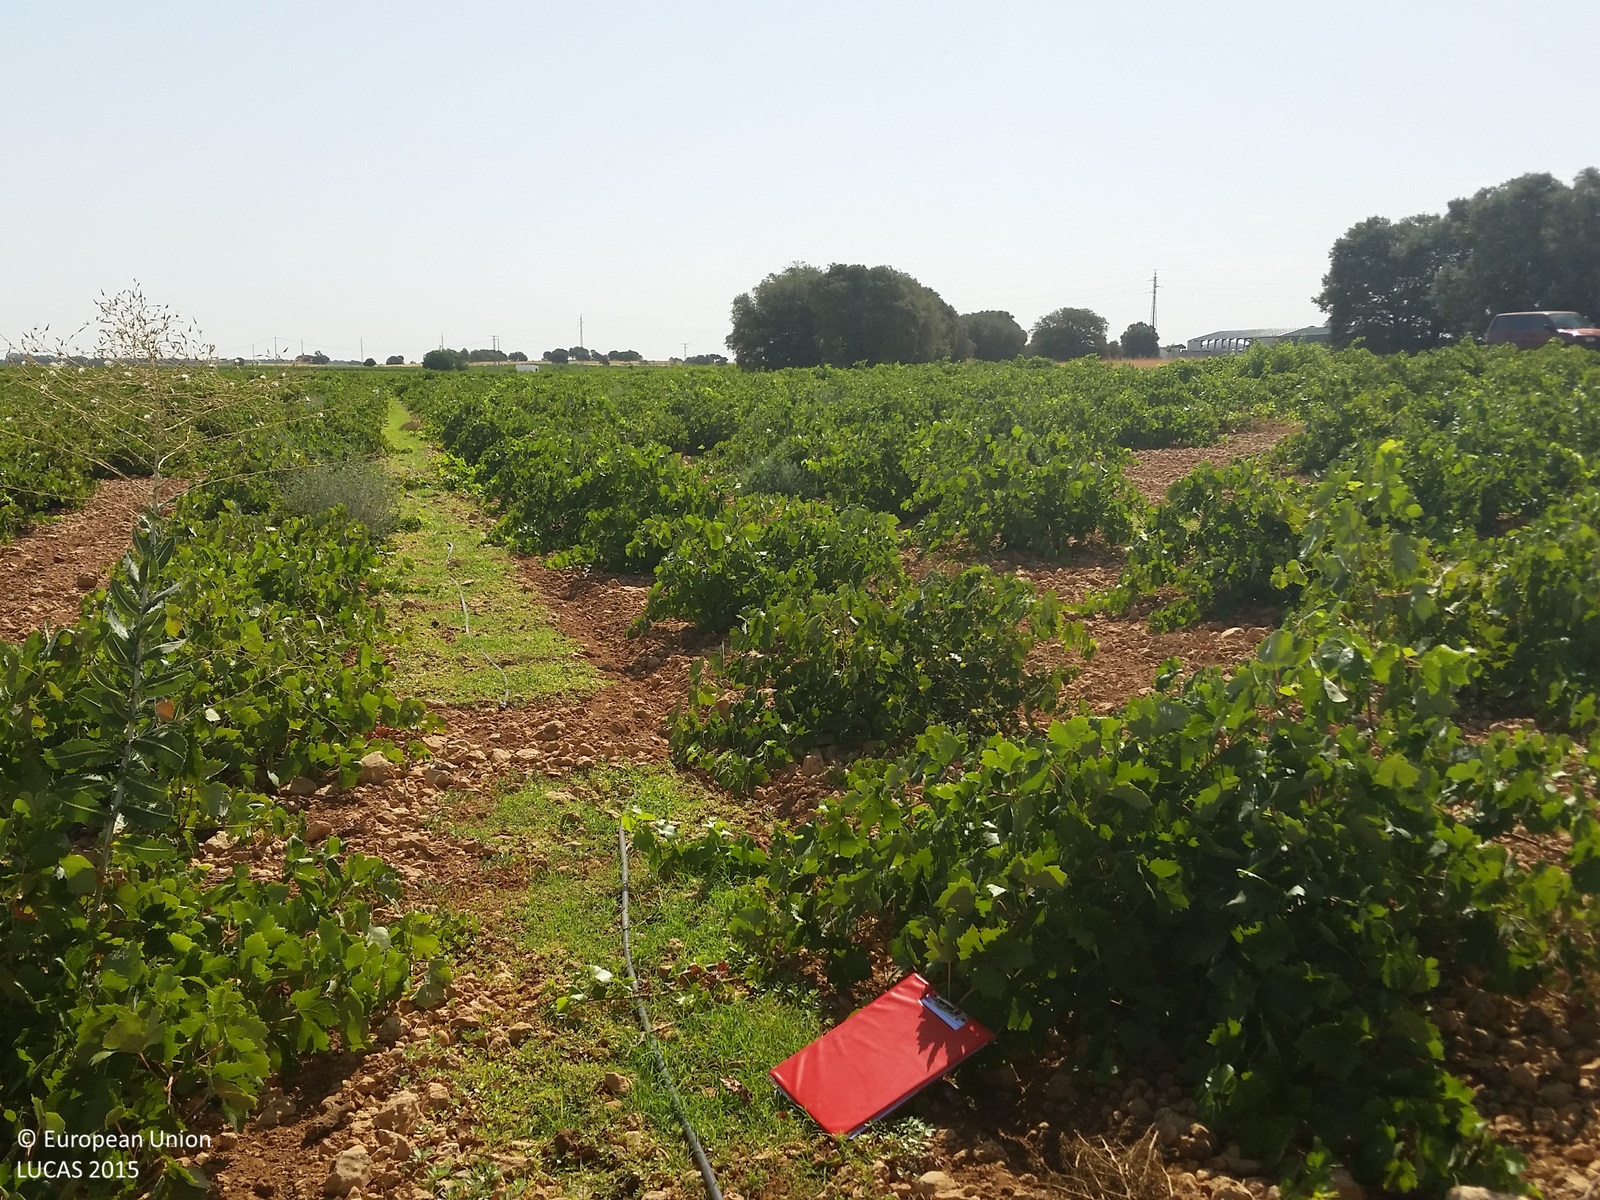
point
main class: Cropland
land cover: Vineyards
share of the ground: 50 - 75 %
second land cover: Spontaneously vegetated surfaces
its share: 50 - 75 %
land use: Agriculture (excluding fallow land and kitchen gardens)
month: July
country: ES
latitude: 39.3090
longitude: -2.5702
